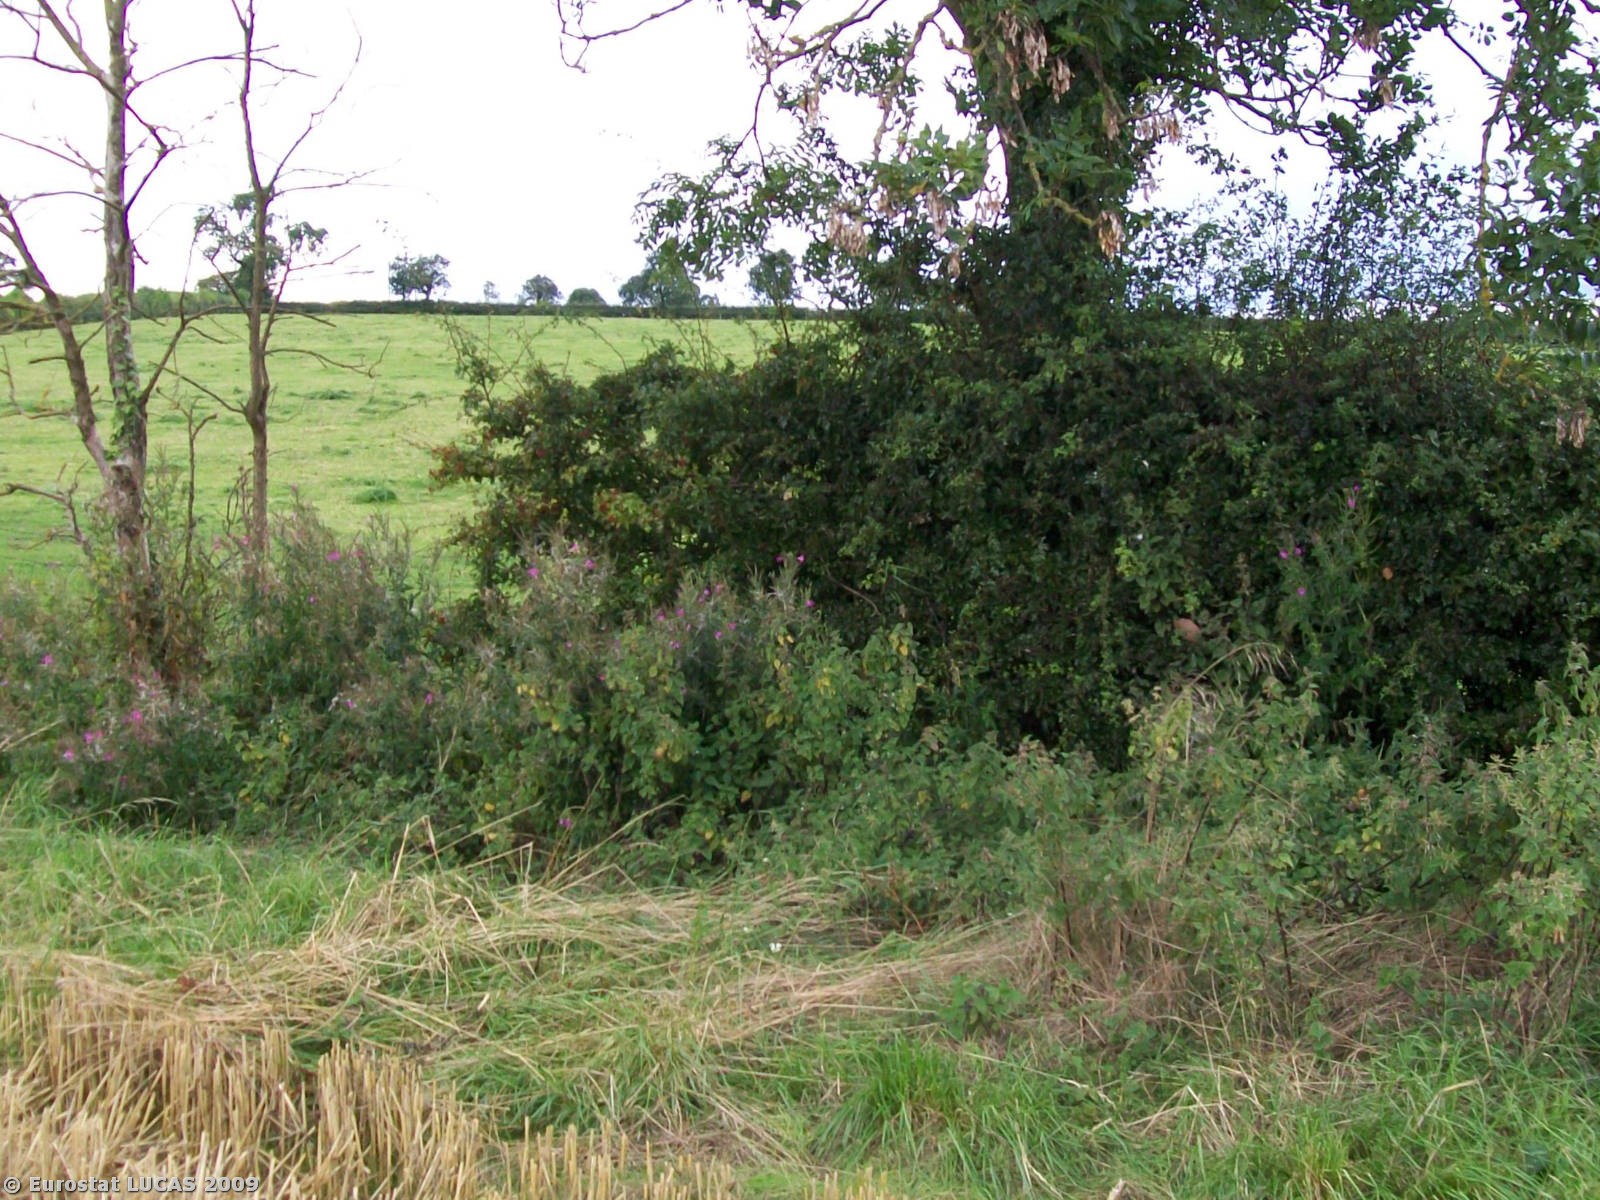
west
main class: Cropland
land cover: Common wheat
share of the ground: < 10 %
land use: Agriculture (excluding fallow land and kitchen gardens)
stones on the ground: < 10 %
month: August
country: GB
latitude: 52.5077
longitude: -1.1104
